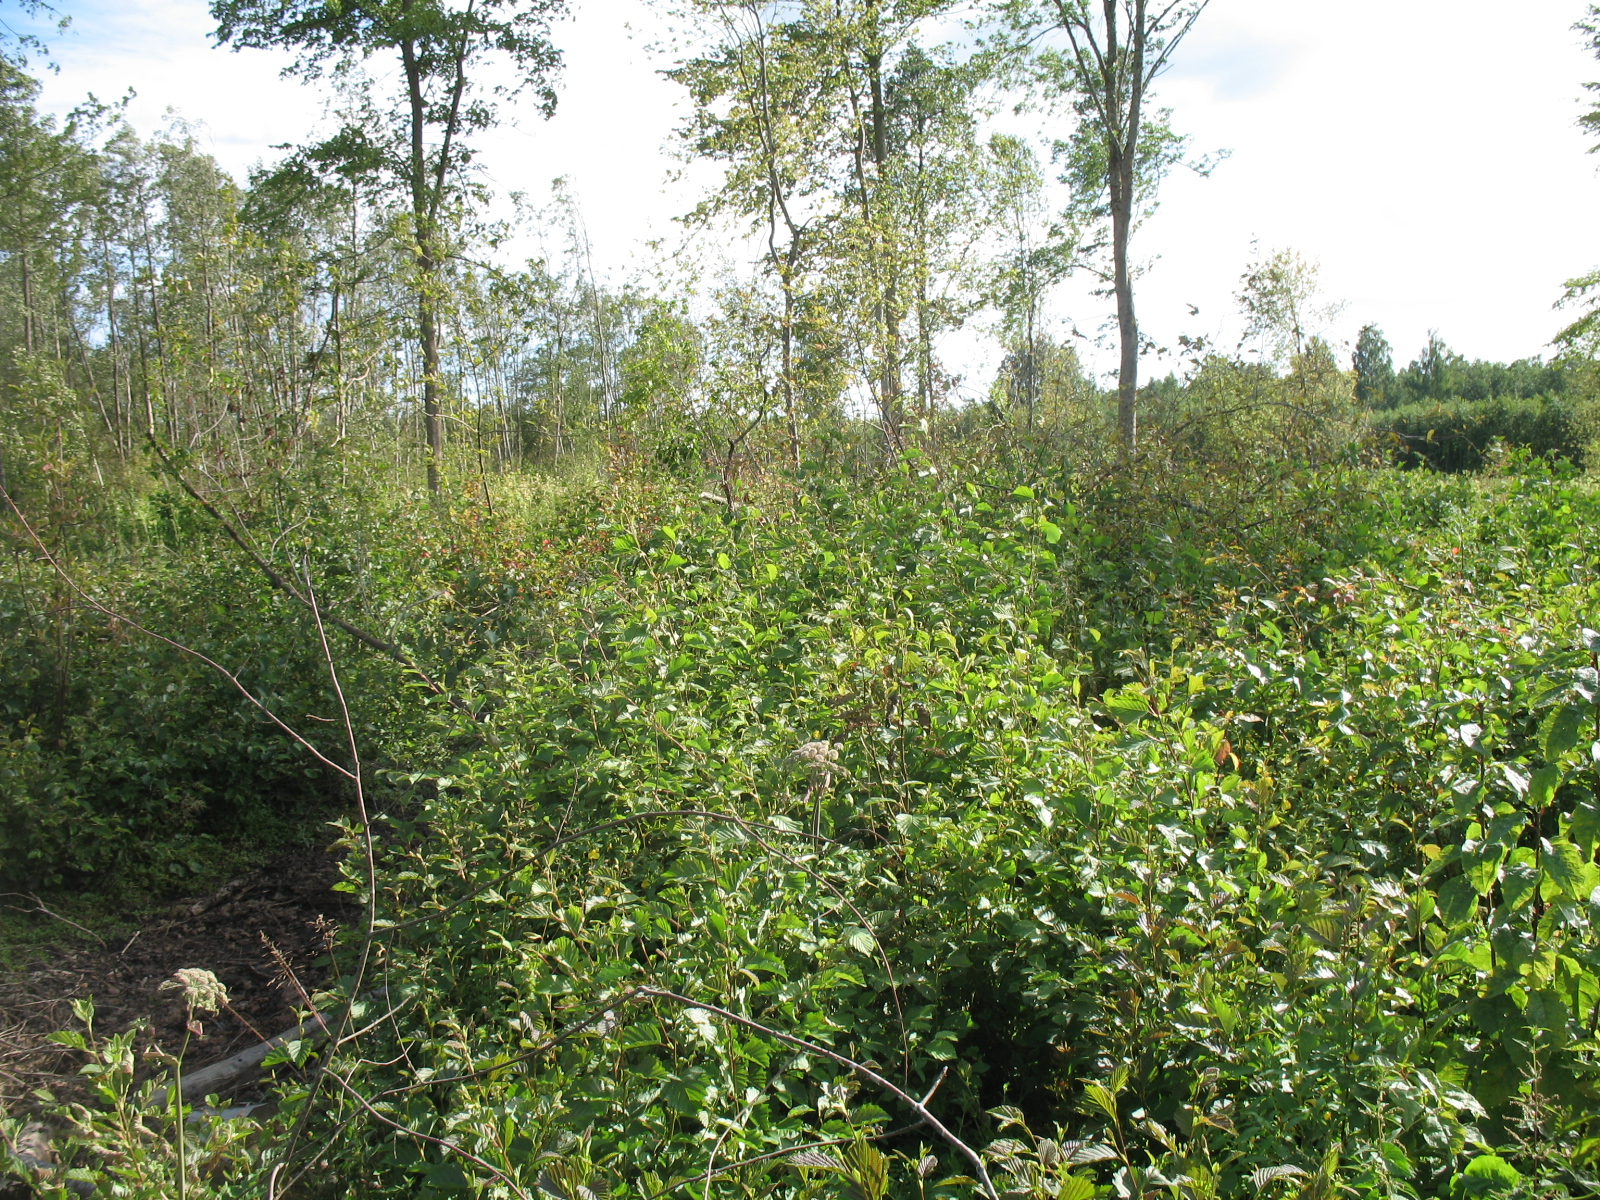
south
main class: Woodland
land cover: Broadleaved woodland
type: non-riverine alder, birch or aspen forest
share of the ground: 50 - 75 %
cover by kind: broadleaved forest trees 60 %, herbaceous plants 40 %
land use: Forestry
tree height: < 5 m
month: July
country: LV
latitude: 56.2712
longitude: 25.1461
